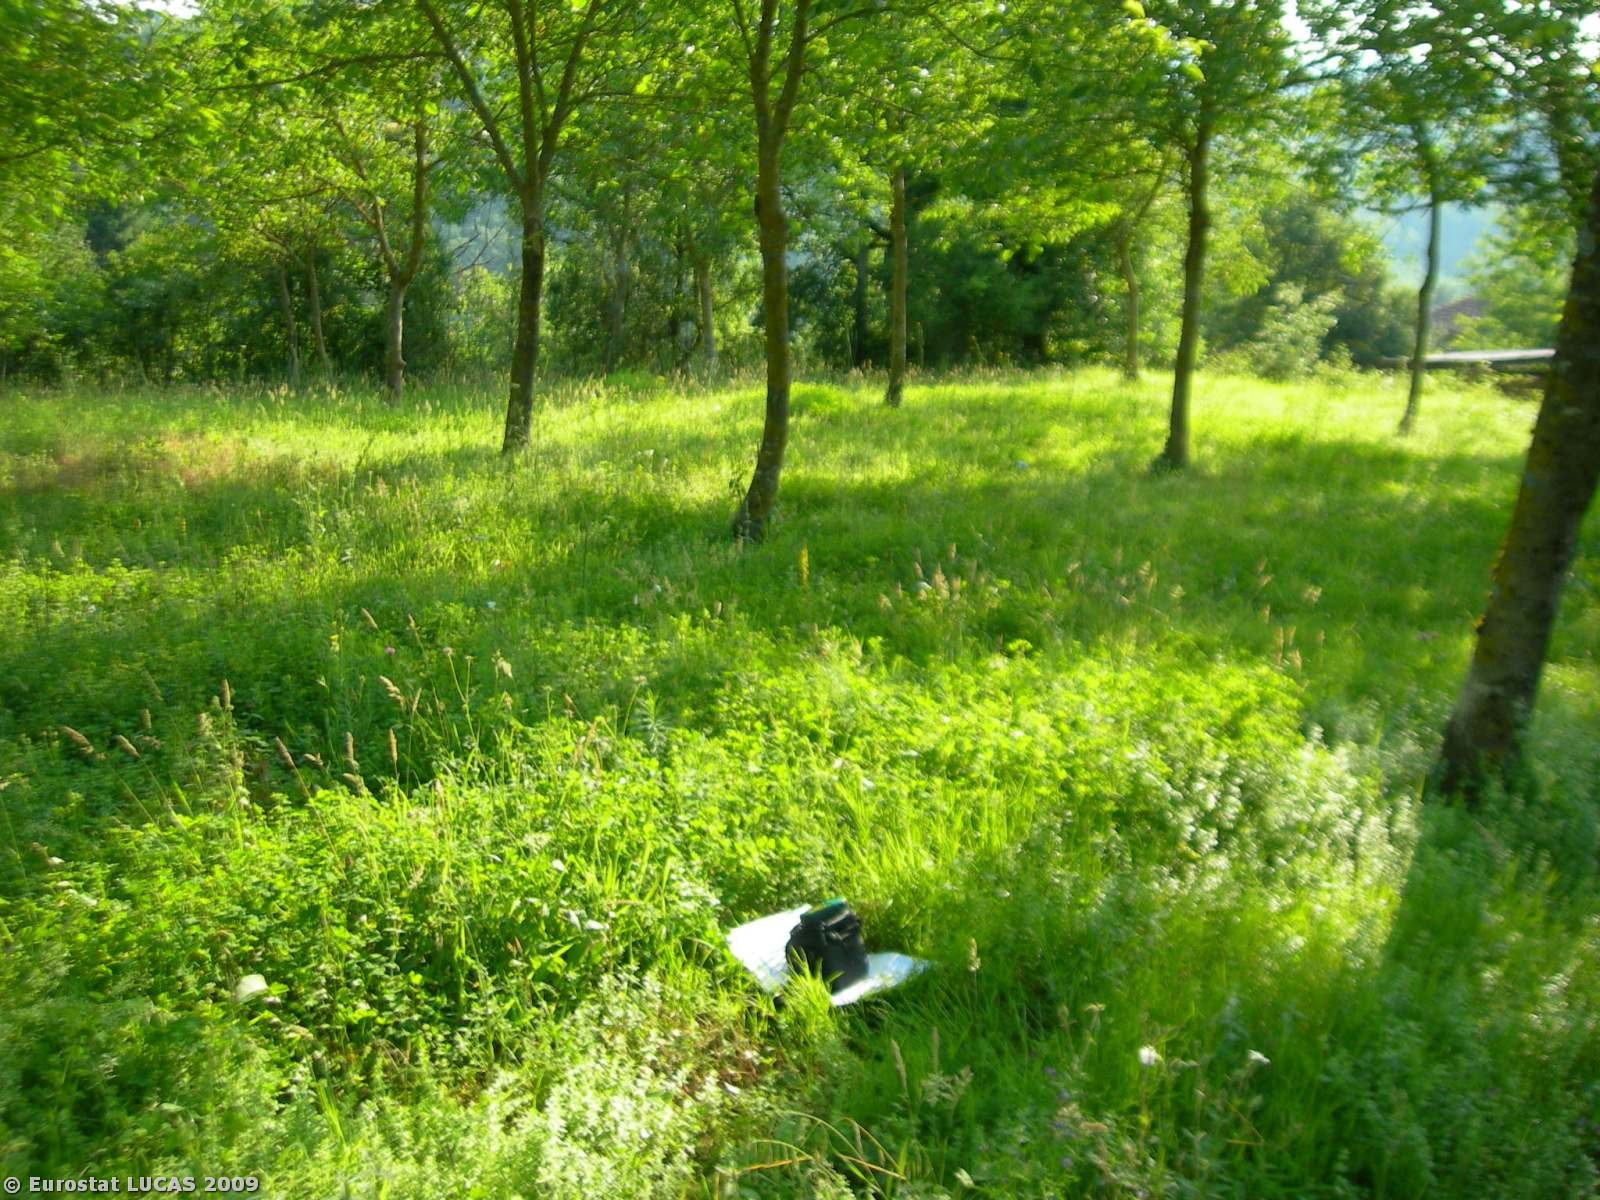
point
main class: Cropland
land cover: Nuts trees
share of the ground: 10 - 25 %
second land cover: Grassland with sparse tree/shrub cover
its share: > 75 %
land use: Agriculture (excluding fallow land and kitchen gardens)
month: July
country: IT
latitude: 43.7593
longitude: 11.6973
